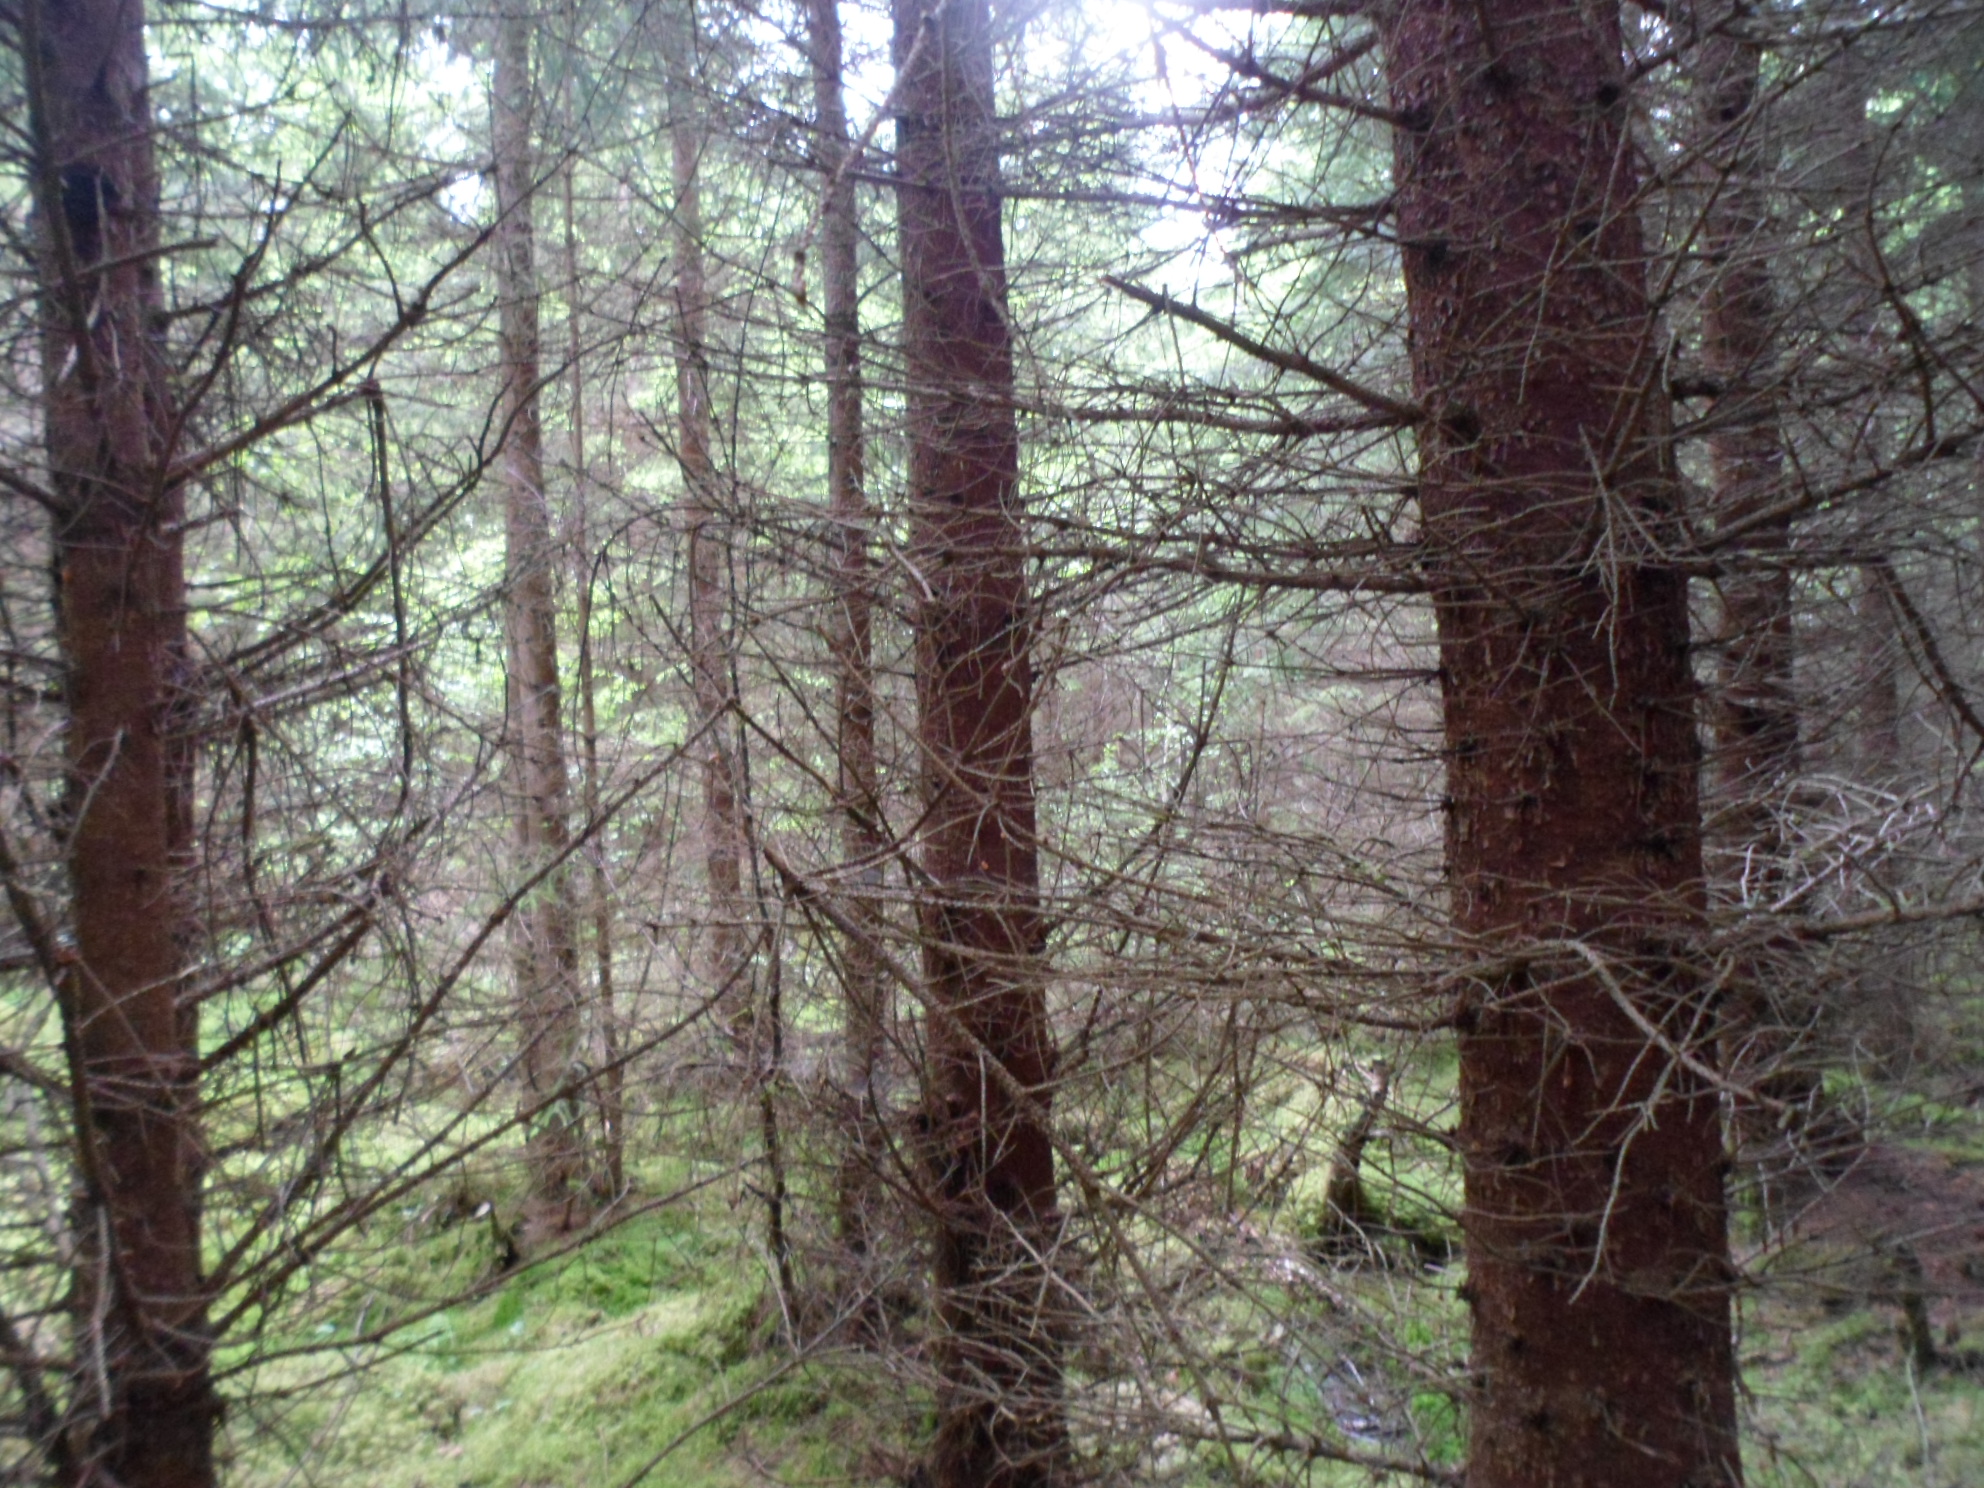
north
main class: Woodland
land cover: Spruce dominated coniferous woodland
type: boreal forest
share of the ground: > 75 %
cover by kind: coniferous forest trees 75 %, lichens and mosses 10 %, broadleaved forest trees 5 %, shrubs 5 %, herbaceous plants 5 %
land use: Forestry
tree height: > 5 m
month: June
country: SE
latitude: 57.1302
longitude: 14.1098
